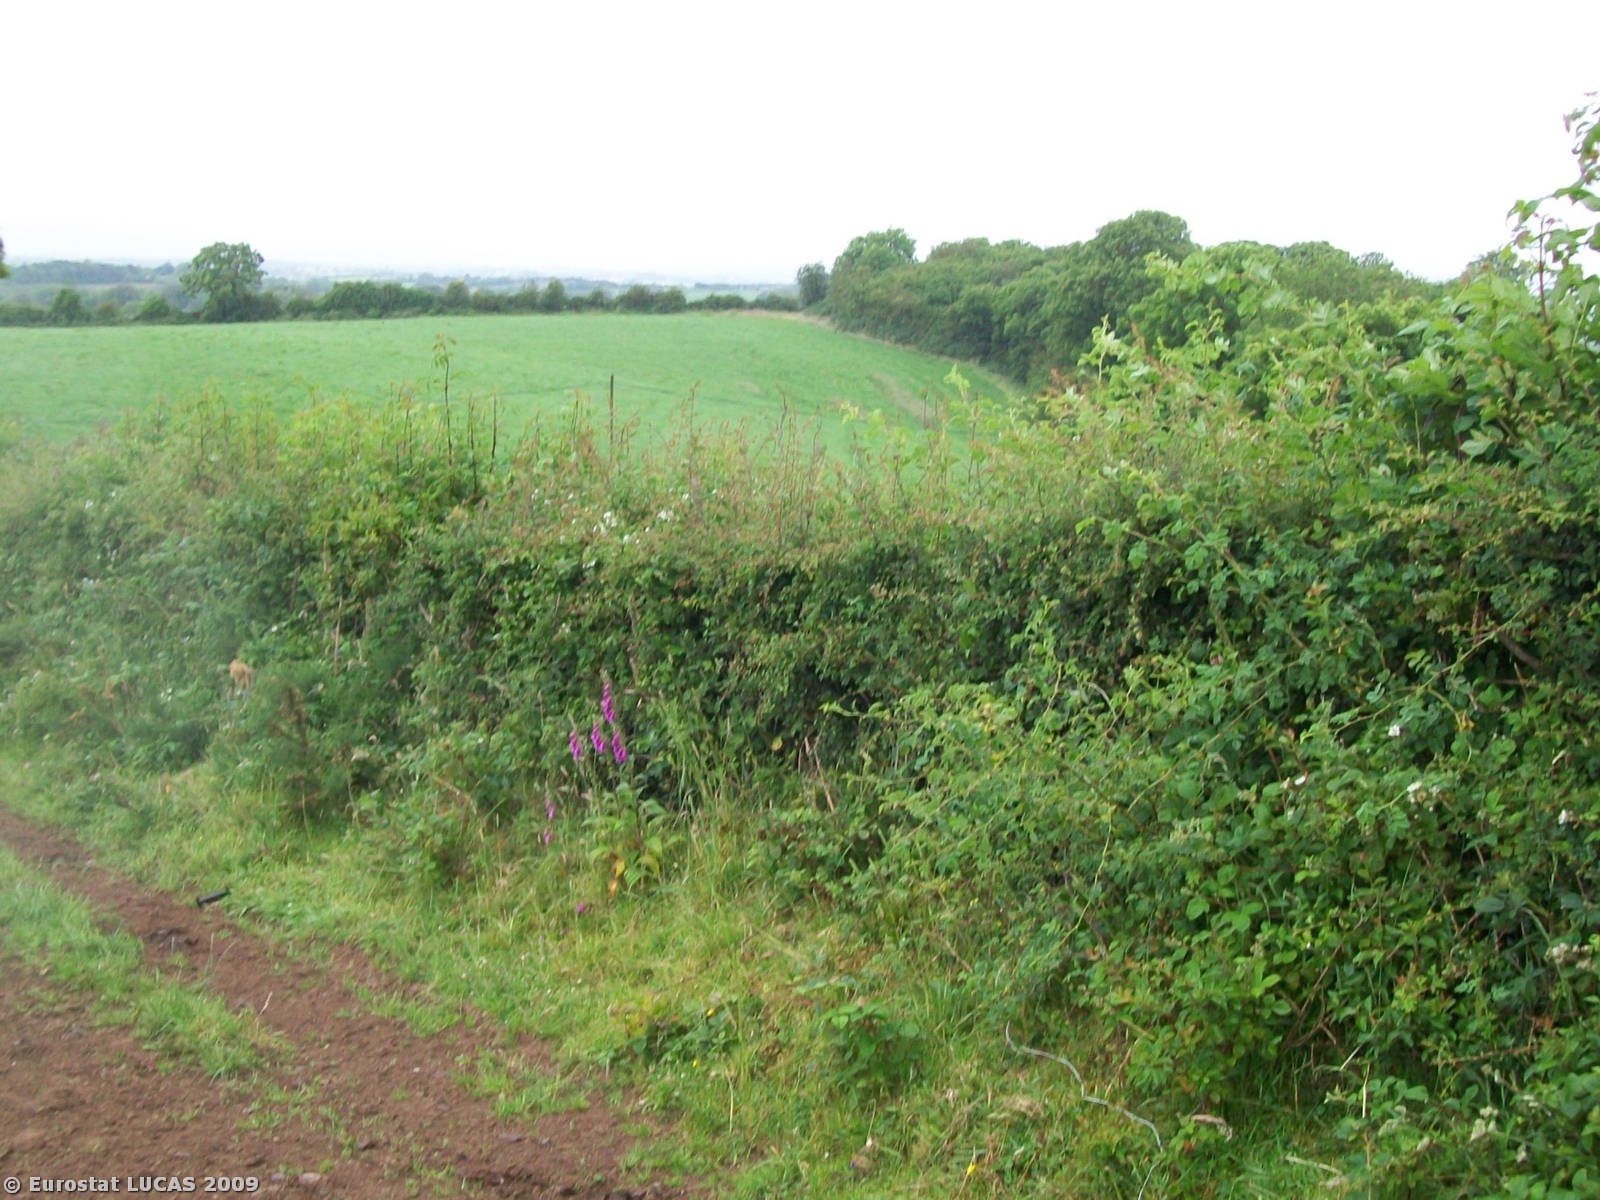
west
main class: Grassland
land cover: Grassland without tree/shrub cover
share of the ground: > 75 %
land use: Agriculture (excluding fallow land and kitchen gardens)
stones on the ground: < 10 %
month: June
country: GB
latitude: 54.4916
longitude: -7.3649
